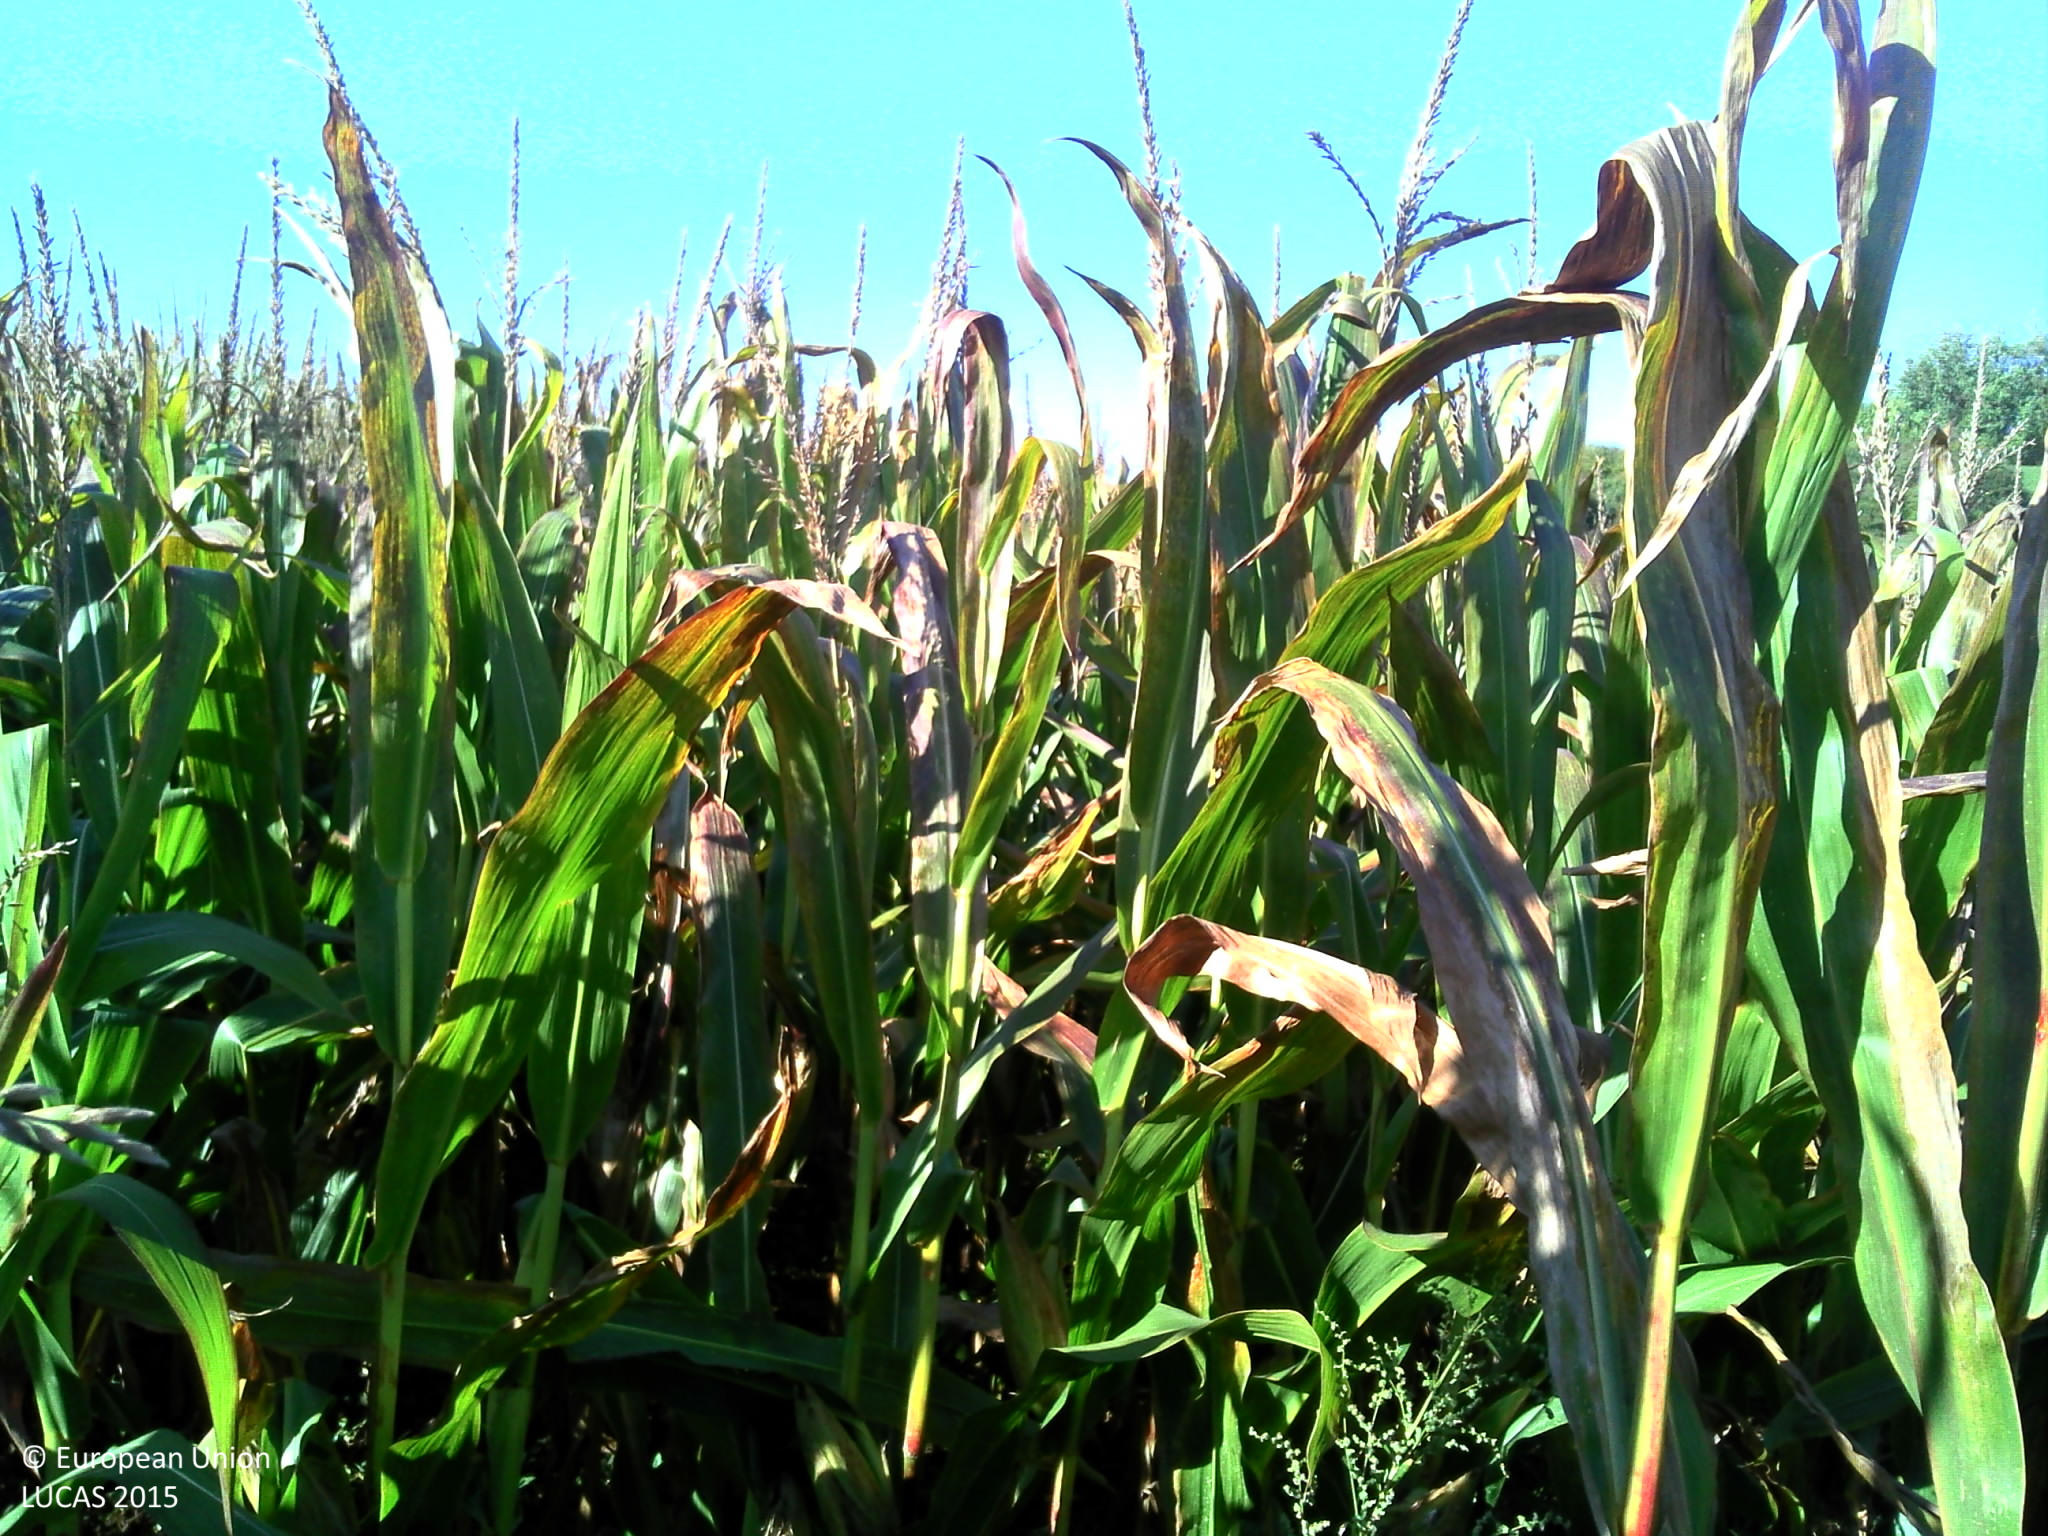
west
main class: Cropland
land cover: Maize
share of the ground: > 75 %
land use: Agriculture (excluding fallow land and kitchen gardens)
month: September
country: FR
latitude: 49.3008
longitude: 5.9149
